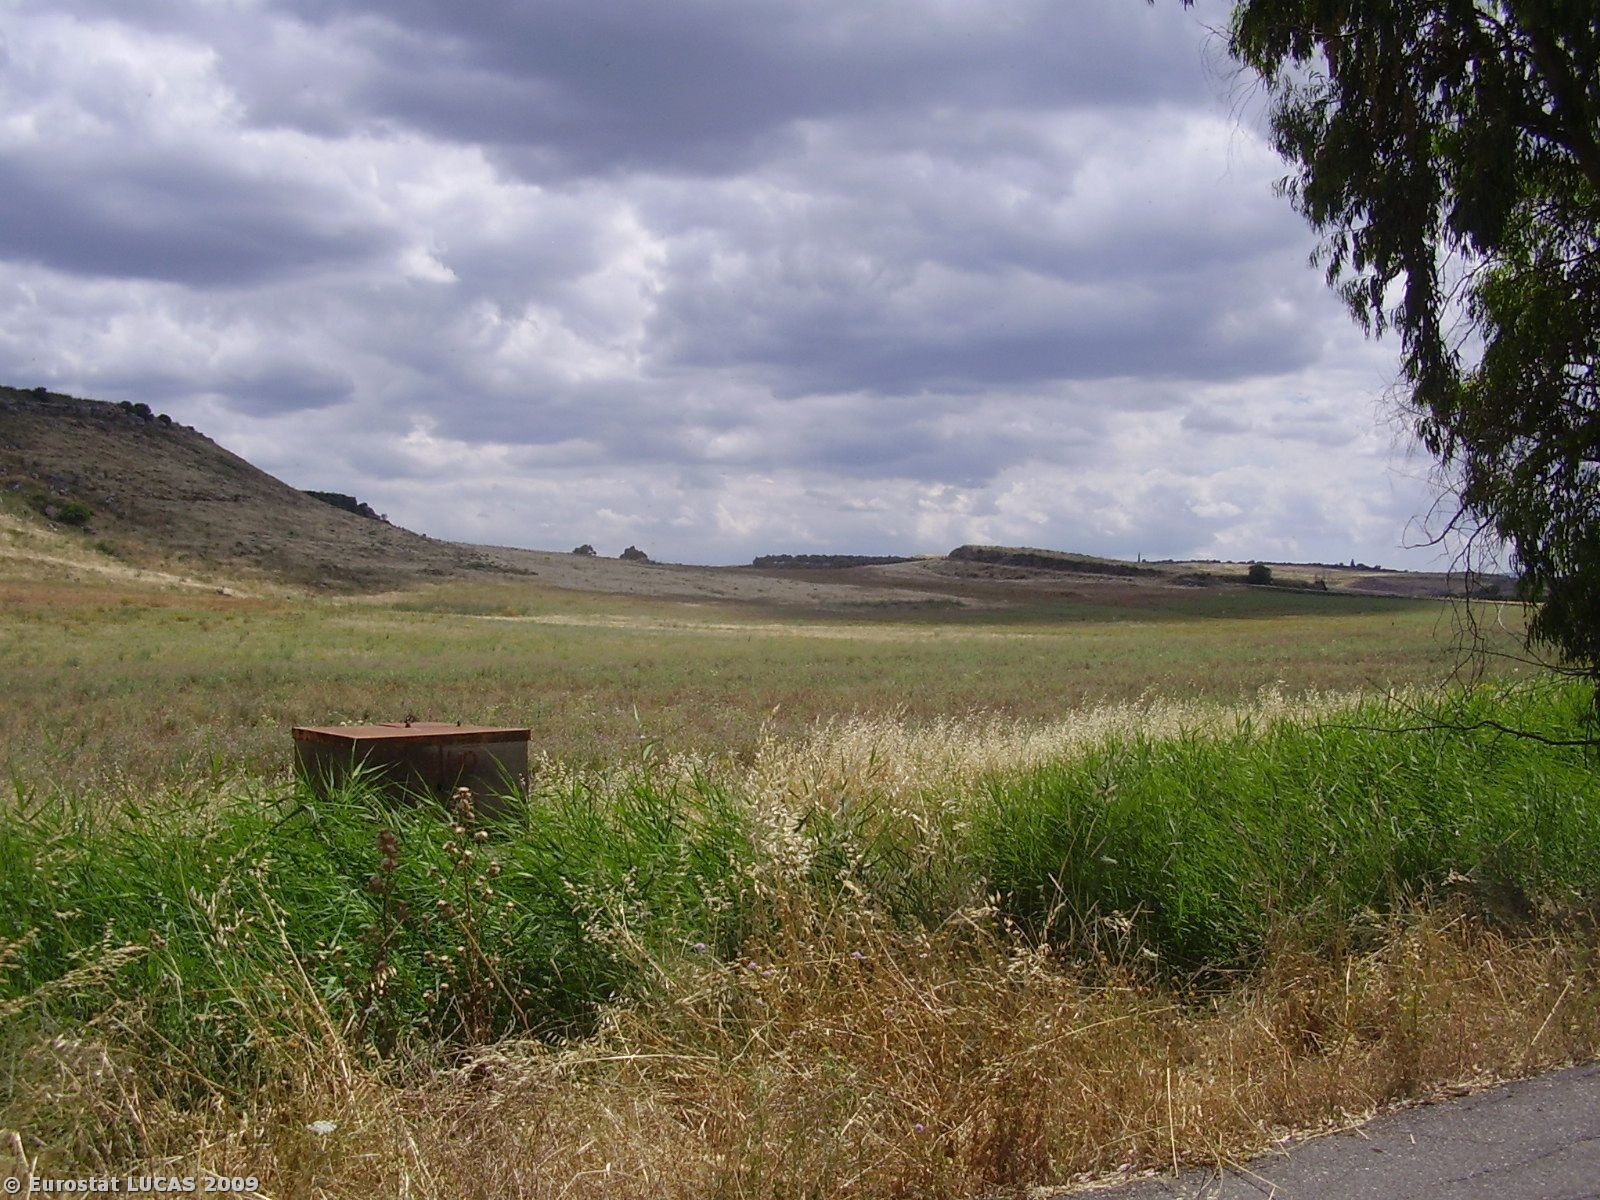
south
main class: Grassland
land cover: Grassland without tree/shrub cover
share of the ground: > 75 %
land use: Fallow land
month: June
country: IT
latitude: 37.3632
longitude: 14.9653
